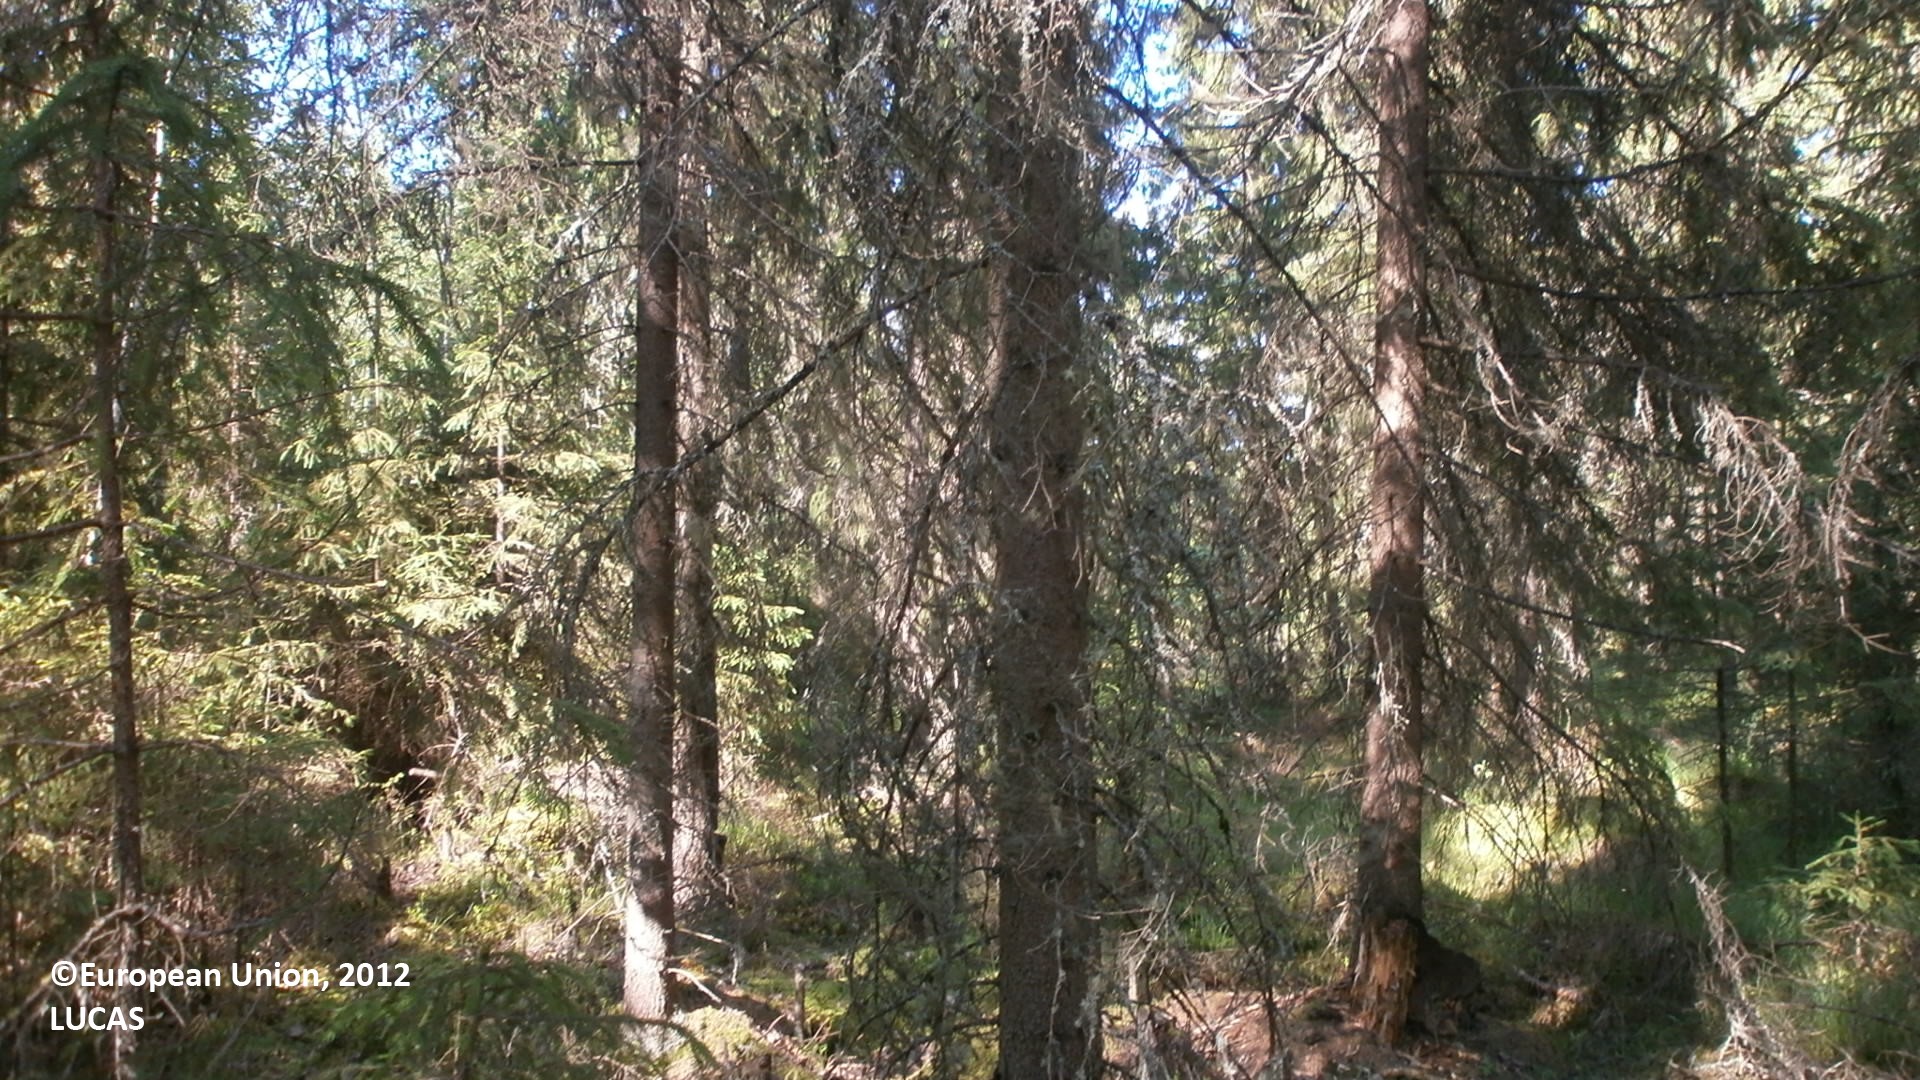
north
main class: Woodland
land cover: Spruce dominated coniferous woodland
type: boreal forest
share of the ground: > 75 %
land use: Forestry
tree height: > 5 m
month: July
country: FI
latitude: 64.0800
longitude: 24.8648
